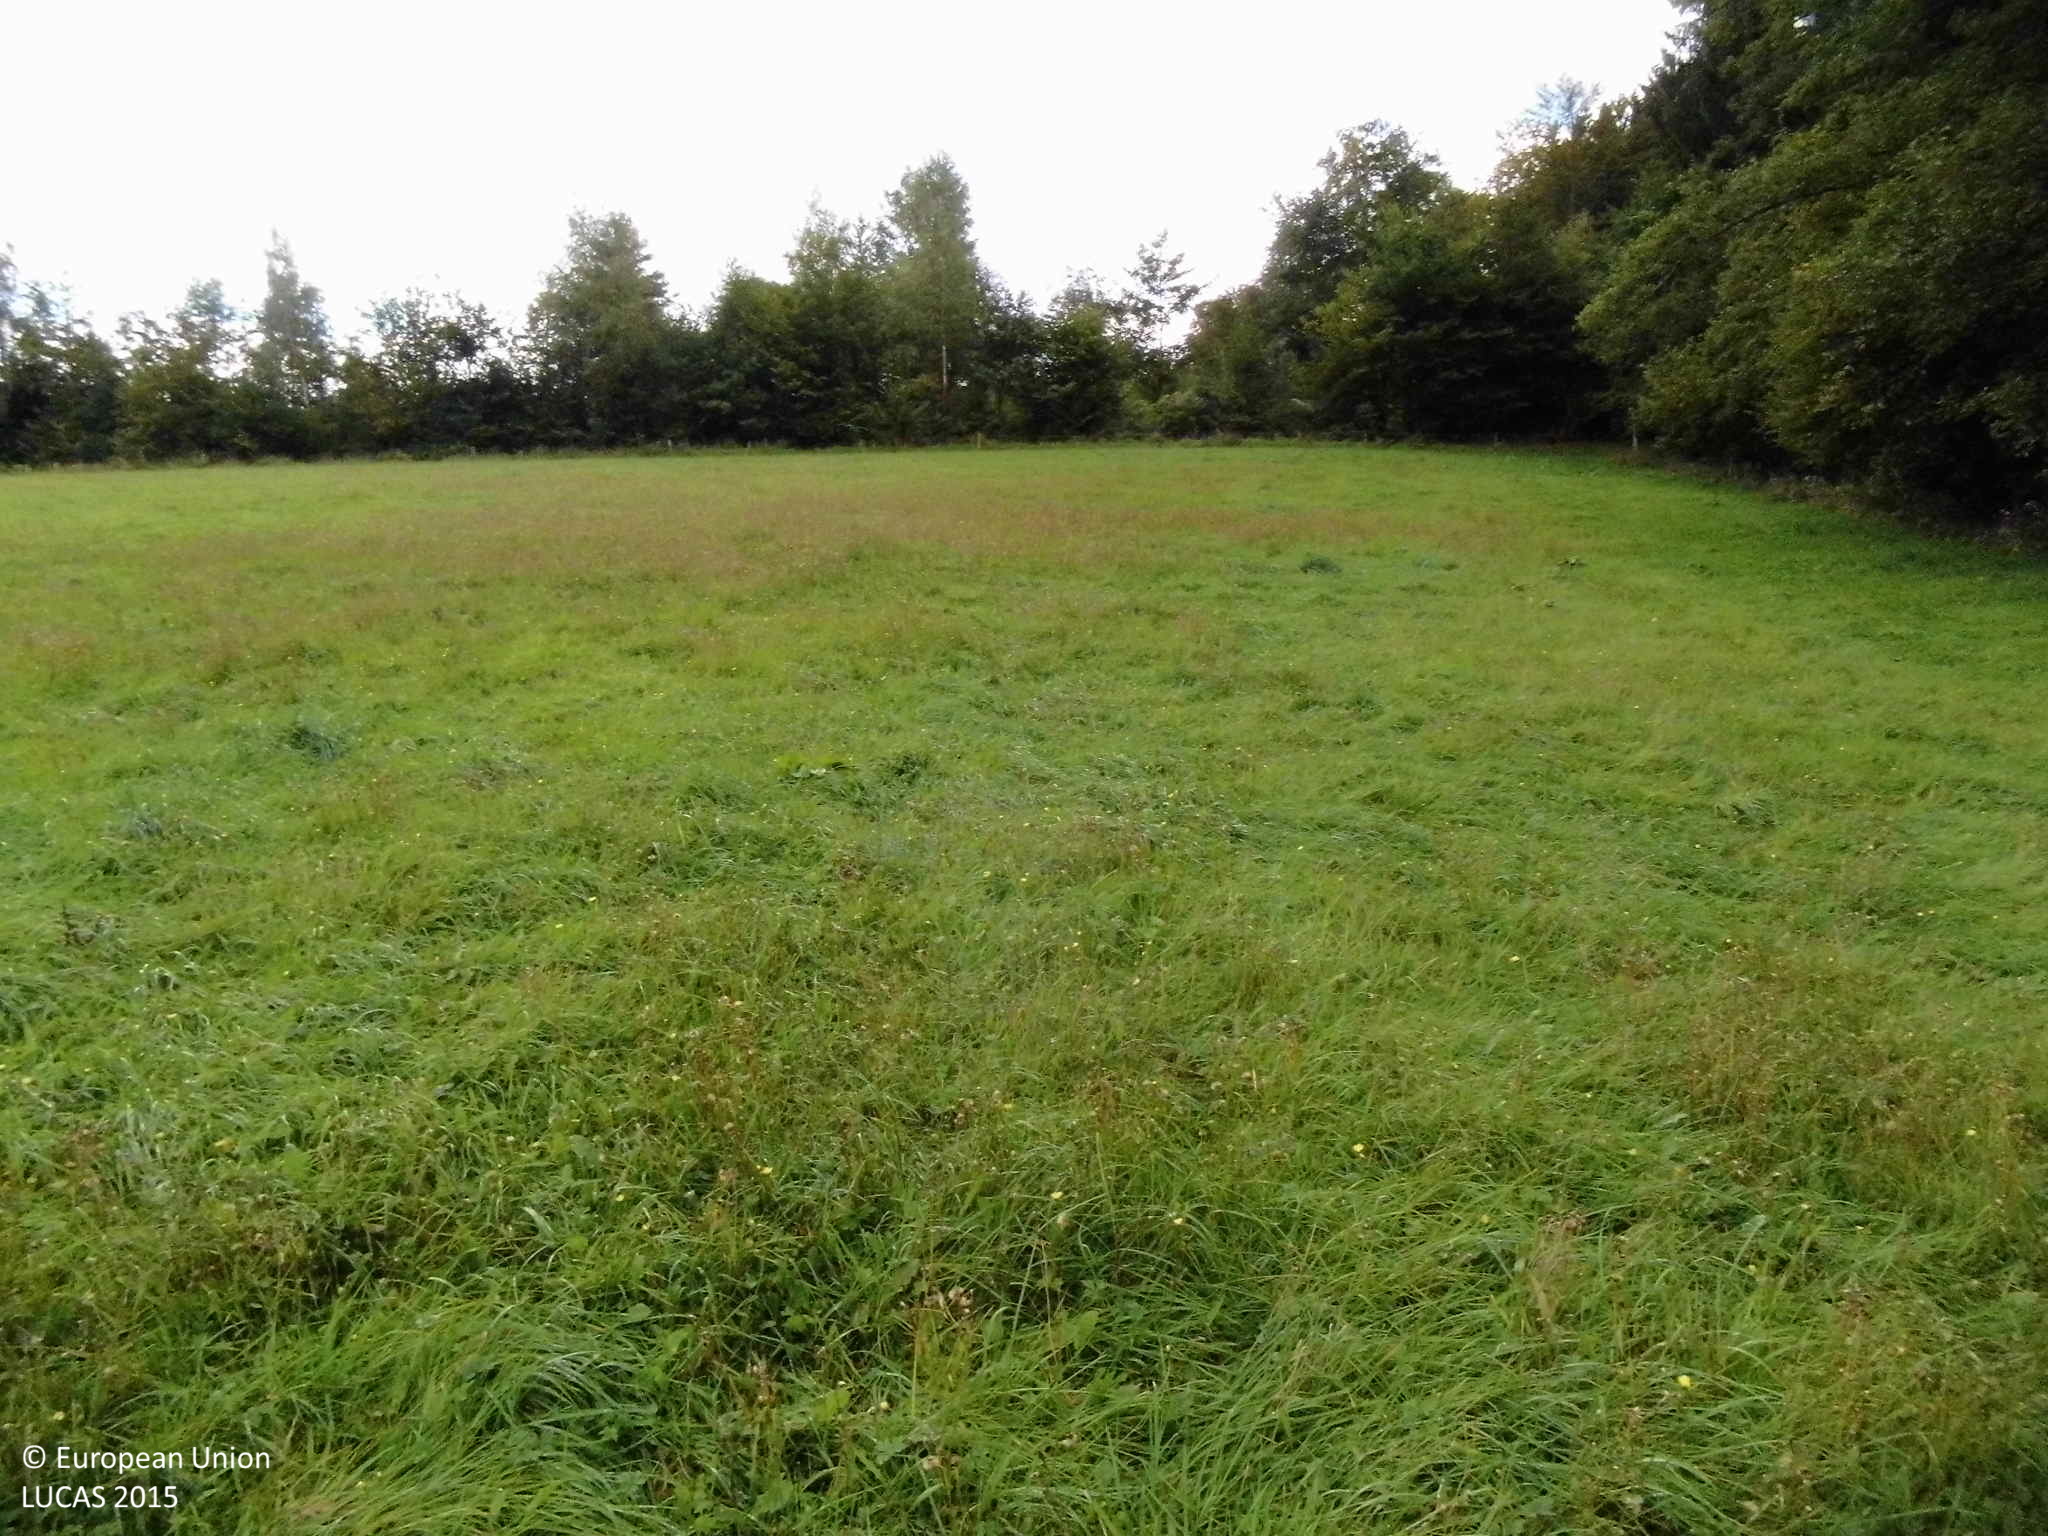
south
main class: Grassland
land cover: Grassland without tree/shrub cover
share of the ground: > 75 %
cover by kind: herbaceous plants 100 %
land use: Agriculture (excluding fallow land and kitchen gardens)
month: September
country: DE
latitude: 50.6592
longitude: 7.4398
